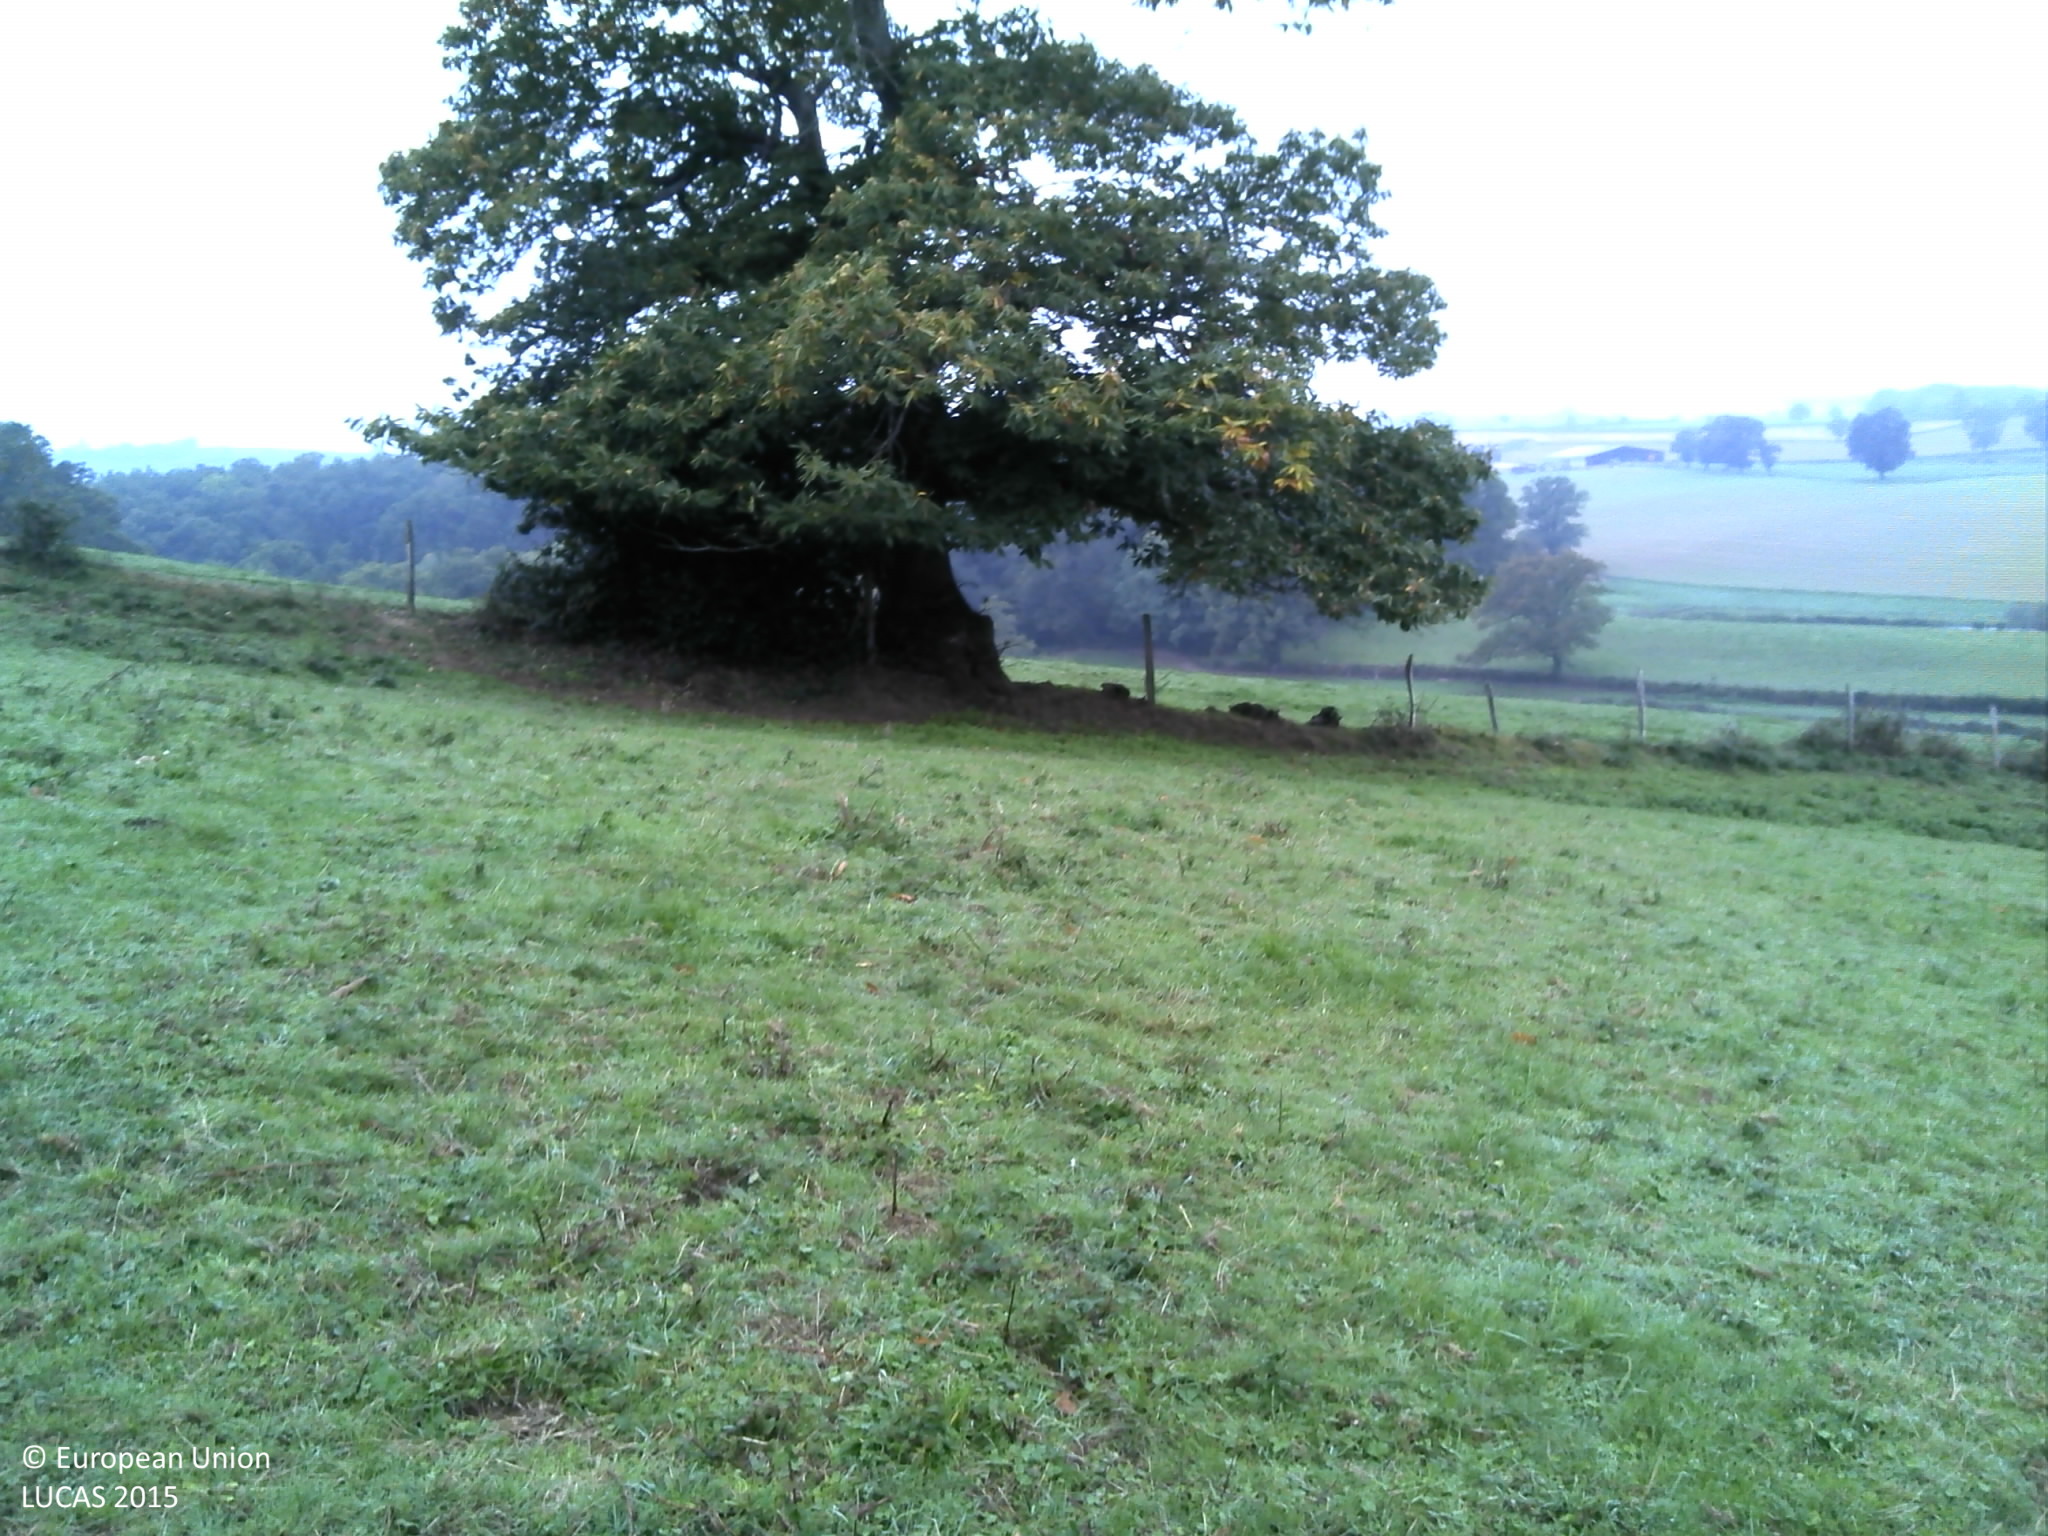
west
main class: Grassland
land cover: Grassland without tree/shrub cover
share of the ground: > 75 %
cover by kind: herbaceous plants 100 %
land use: Agriculture (excluding fallow land and kitchen gardens)
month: October
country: FR
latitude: 46.7615
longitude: 4.0161
